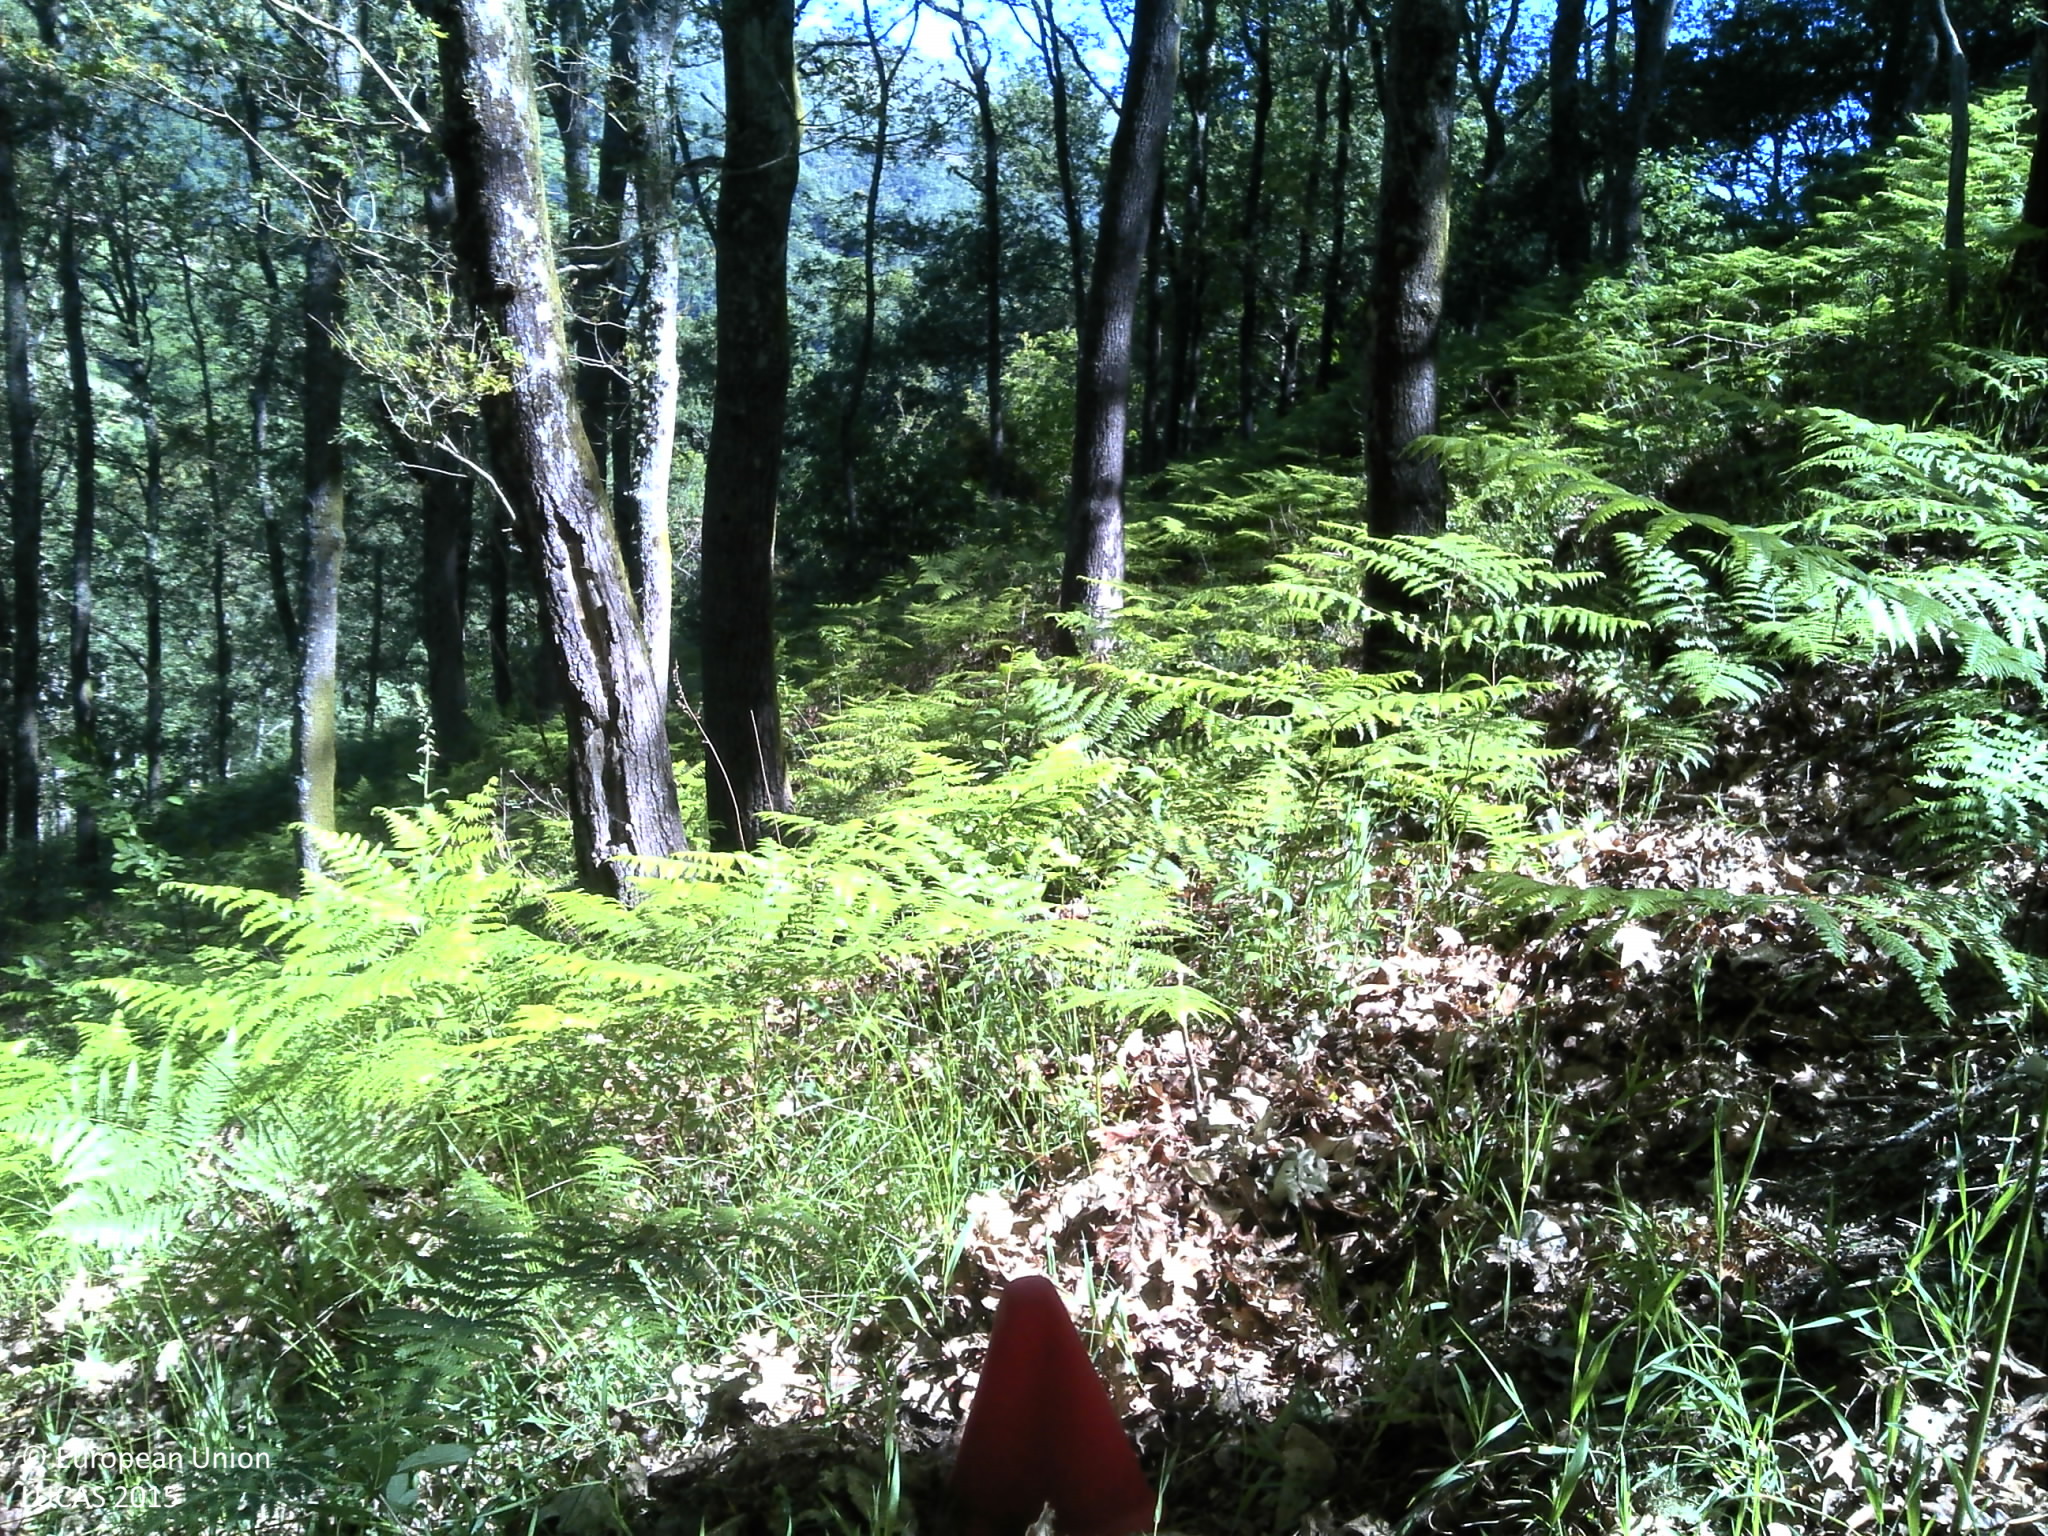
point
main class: Woodland
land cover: Broadleaved woodland
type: thermophilous deciduous forest
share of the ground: 50 - 75 %
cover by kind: broadleaved forest trees 75 %, shrubs 10 %, unconsolidated bare surface 10 %, herbaceous plants 5 %
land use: Forestry
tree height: > 5 m
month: May
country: PT
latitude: 40.9408
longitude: -7.9591
